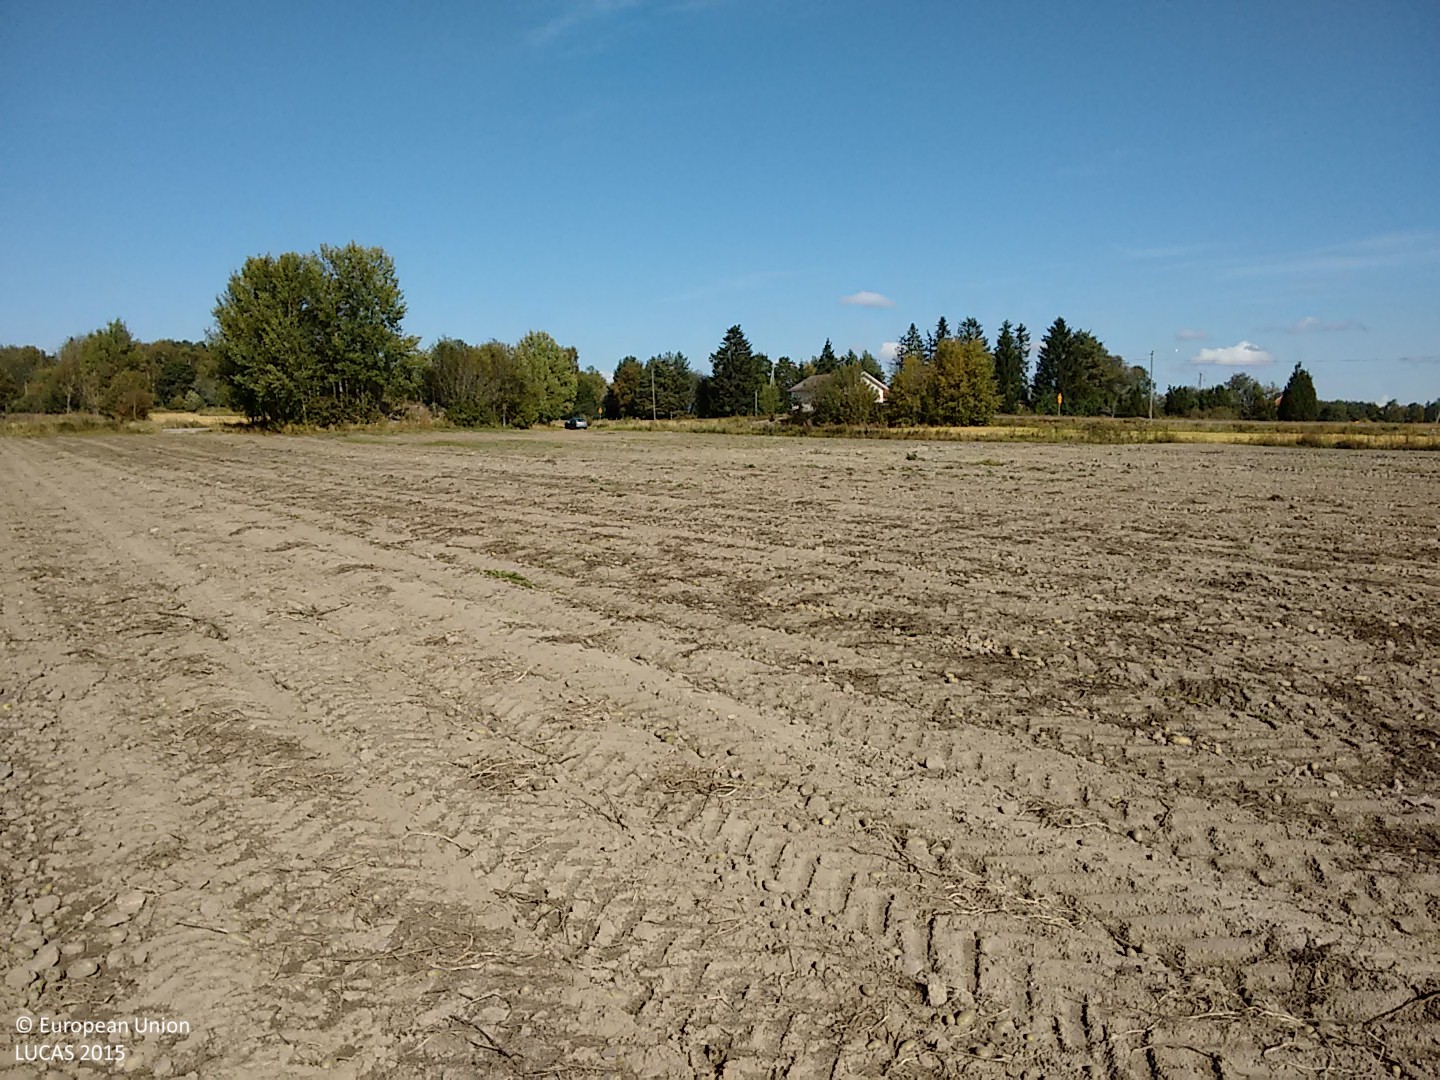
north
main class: Cropland
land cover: Potatoes
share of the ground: < 10 %
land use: Agriculture (excluding fallow land and kitchen gardens)
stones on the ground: < 10 %
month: September
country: FI
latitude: 60.9141
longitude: 21.6929
